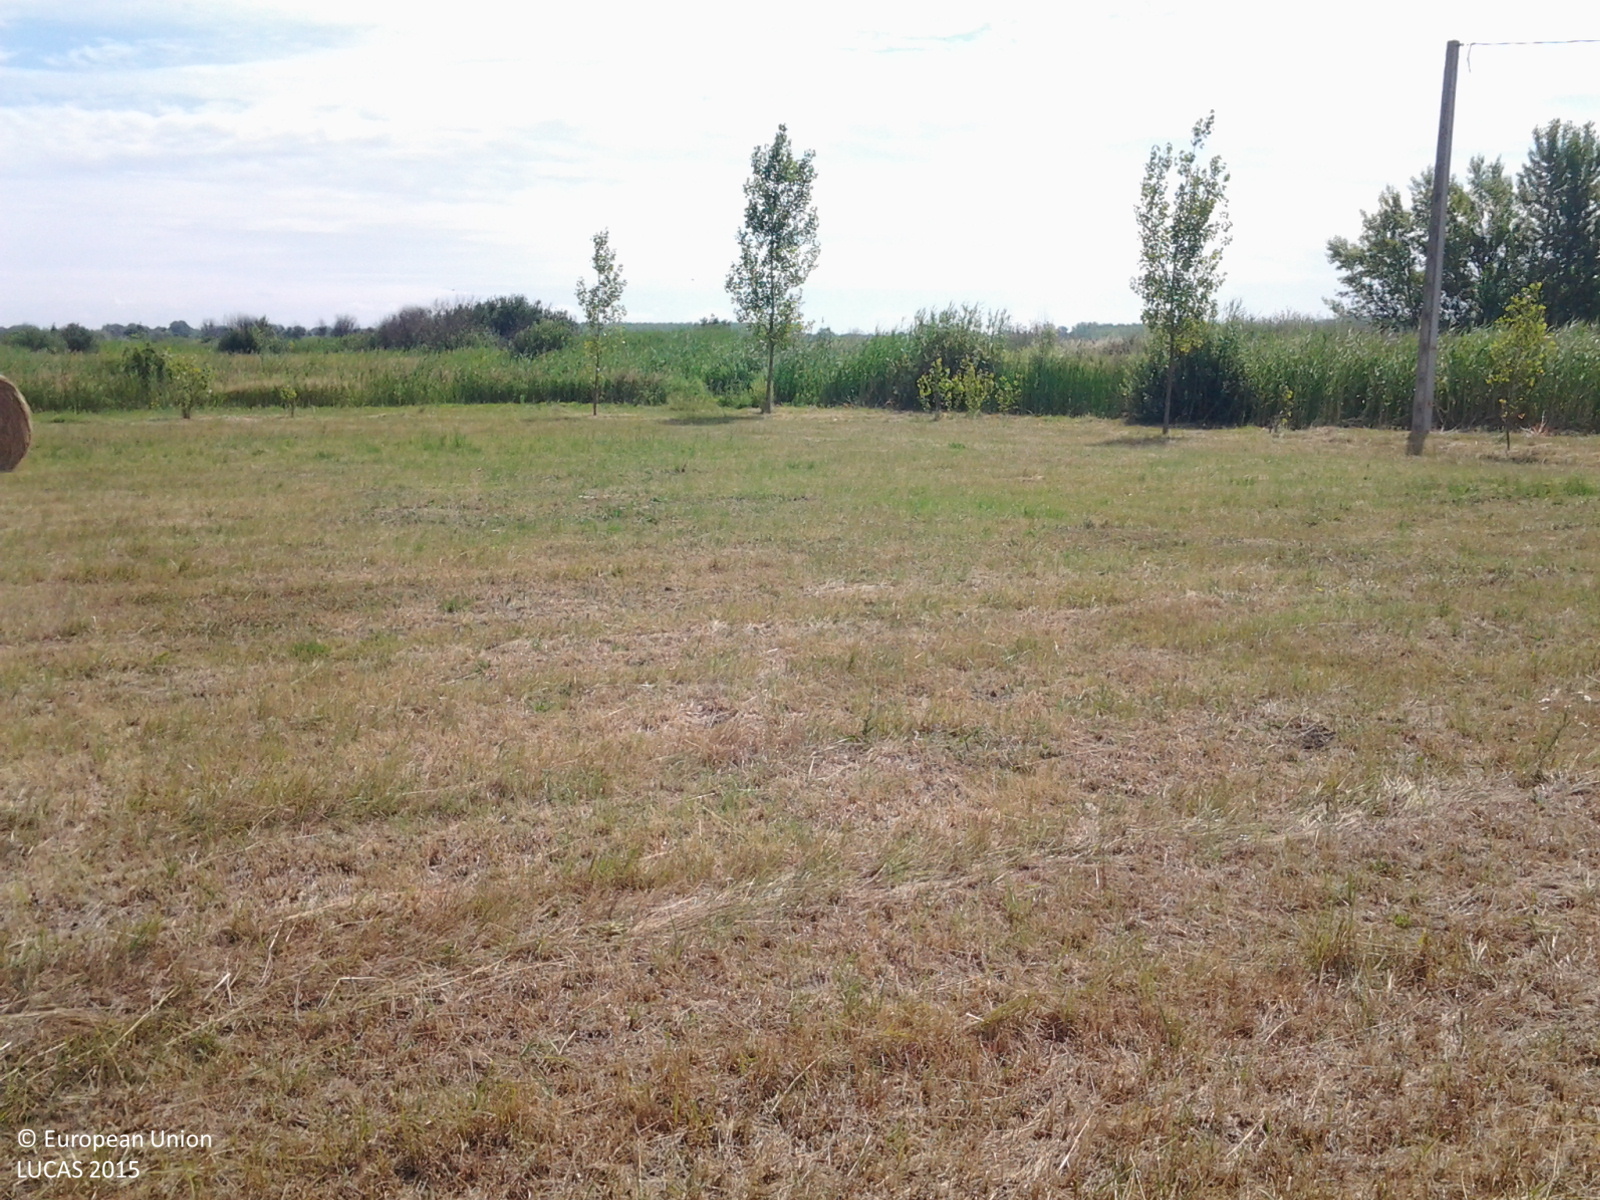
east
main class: Grassland
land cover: Grassland without tree/shrub cover
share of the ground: > 75 %
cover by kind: herbaceous plants 100 %
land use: Agriculture (excluding fallow land and kitchen gardens)
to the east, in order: Grassland without tree/shrub cover; Ditches and canals; Spontaneously vegetated surfaces; Inland fresh running water; Spontaneously vegetated surfaces; Barley
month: June
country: HU
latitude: 47.0824
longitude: 20.1545
